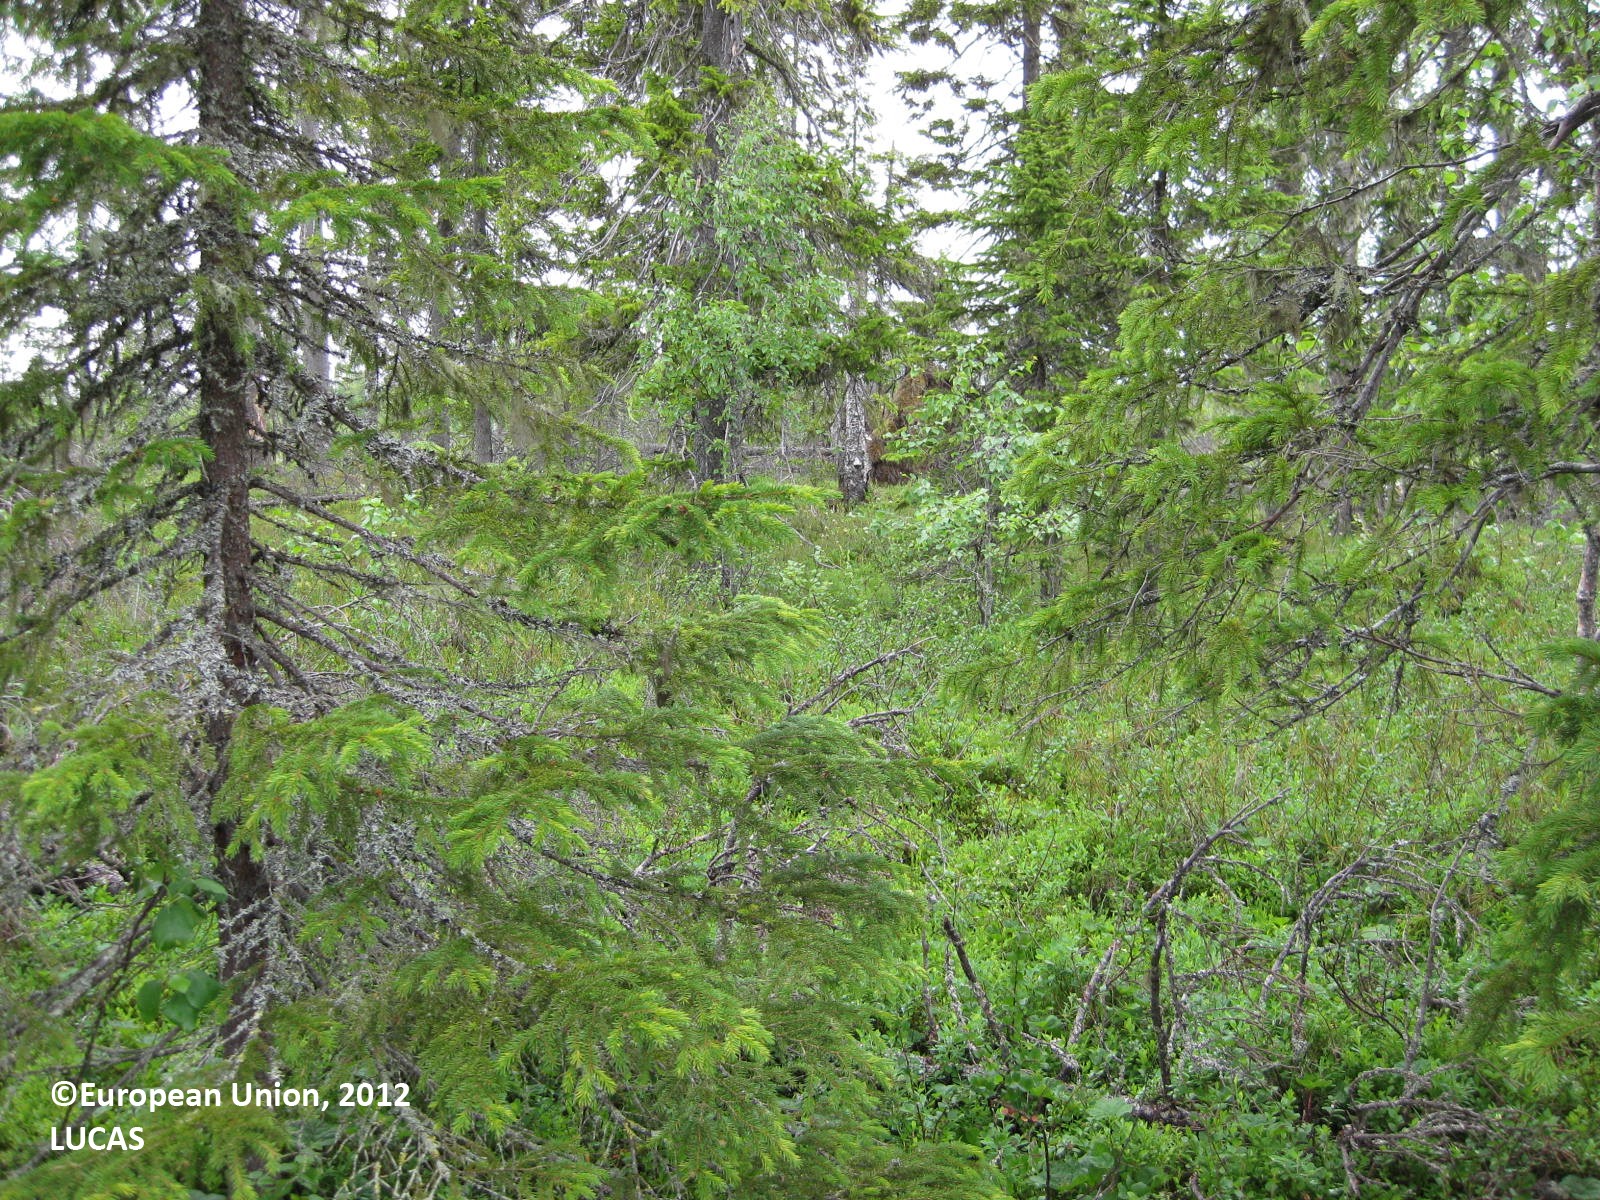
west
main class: Woodland
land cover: Spruce dominated coniferous woodland
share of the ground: 25 - 50 %
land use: Forestry
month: July
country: FI
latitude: 65.4562
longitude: 28.3894
